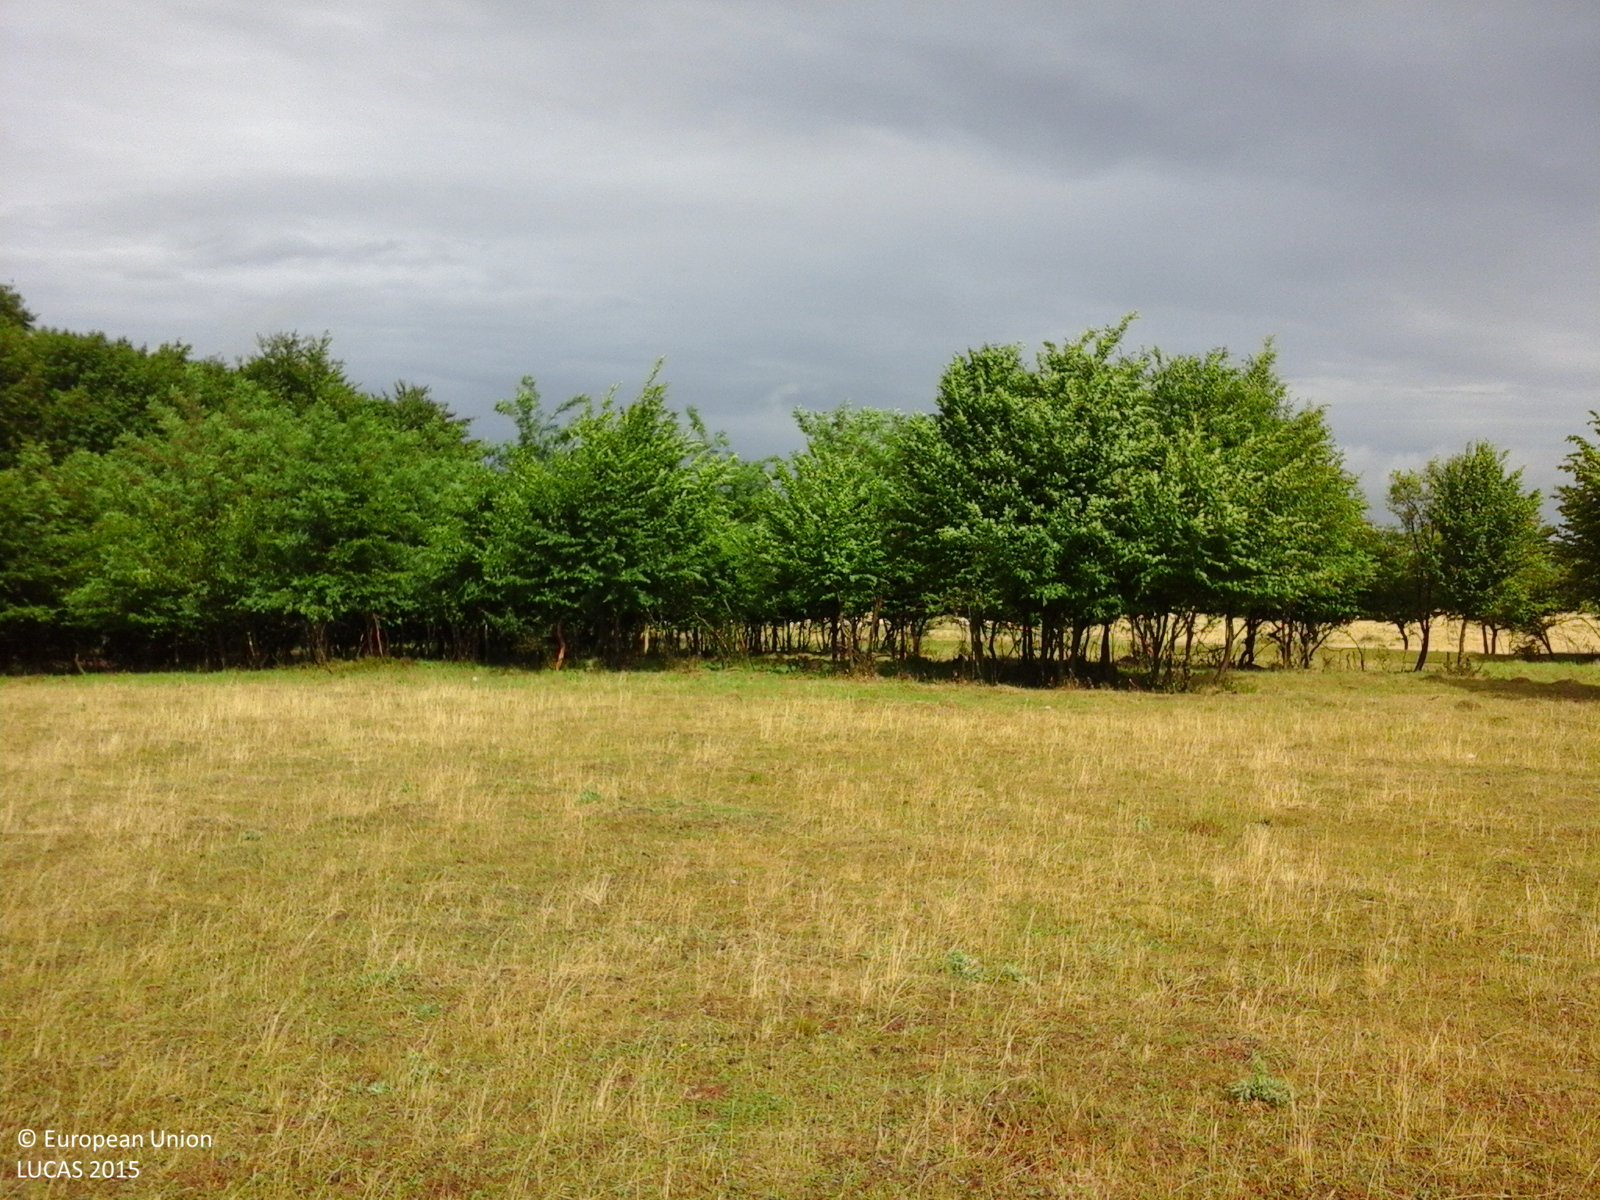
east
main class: Grassland
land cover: Grassland without tree/shrub cover
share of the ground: > 75 %
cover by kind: herbaceous plants 100 %
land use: Agriculture (excluding fallow land and kitchen gardens)
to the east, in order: Grassland without tree/shrub cover; Broadleaved woodland; Ditches and canals; Grassland without tree/shrub cover; Tracks; Grassland without tree/shrub cover; Tracks; Grassland without tree/shrub cover
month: June
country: RO
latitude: 47.4202
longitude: 26.4301
